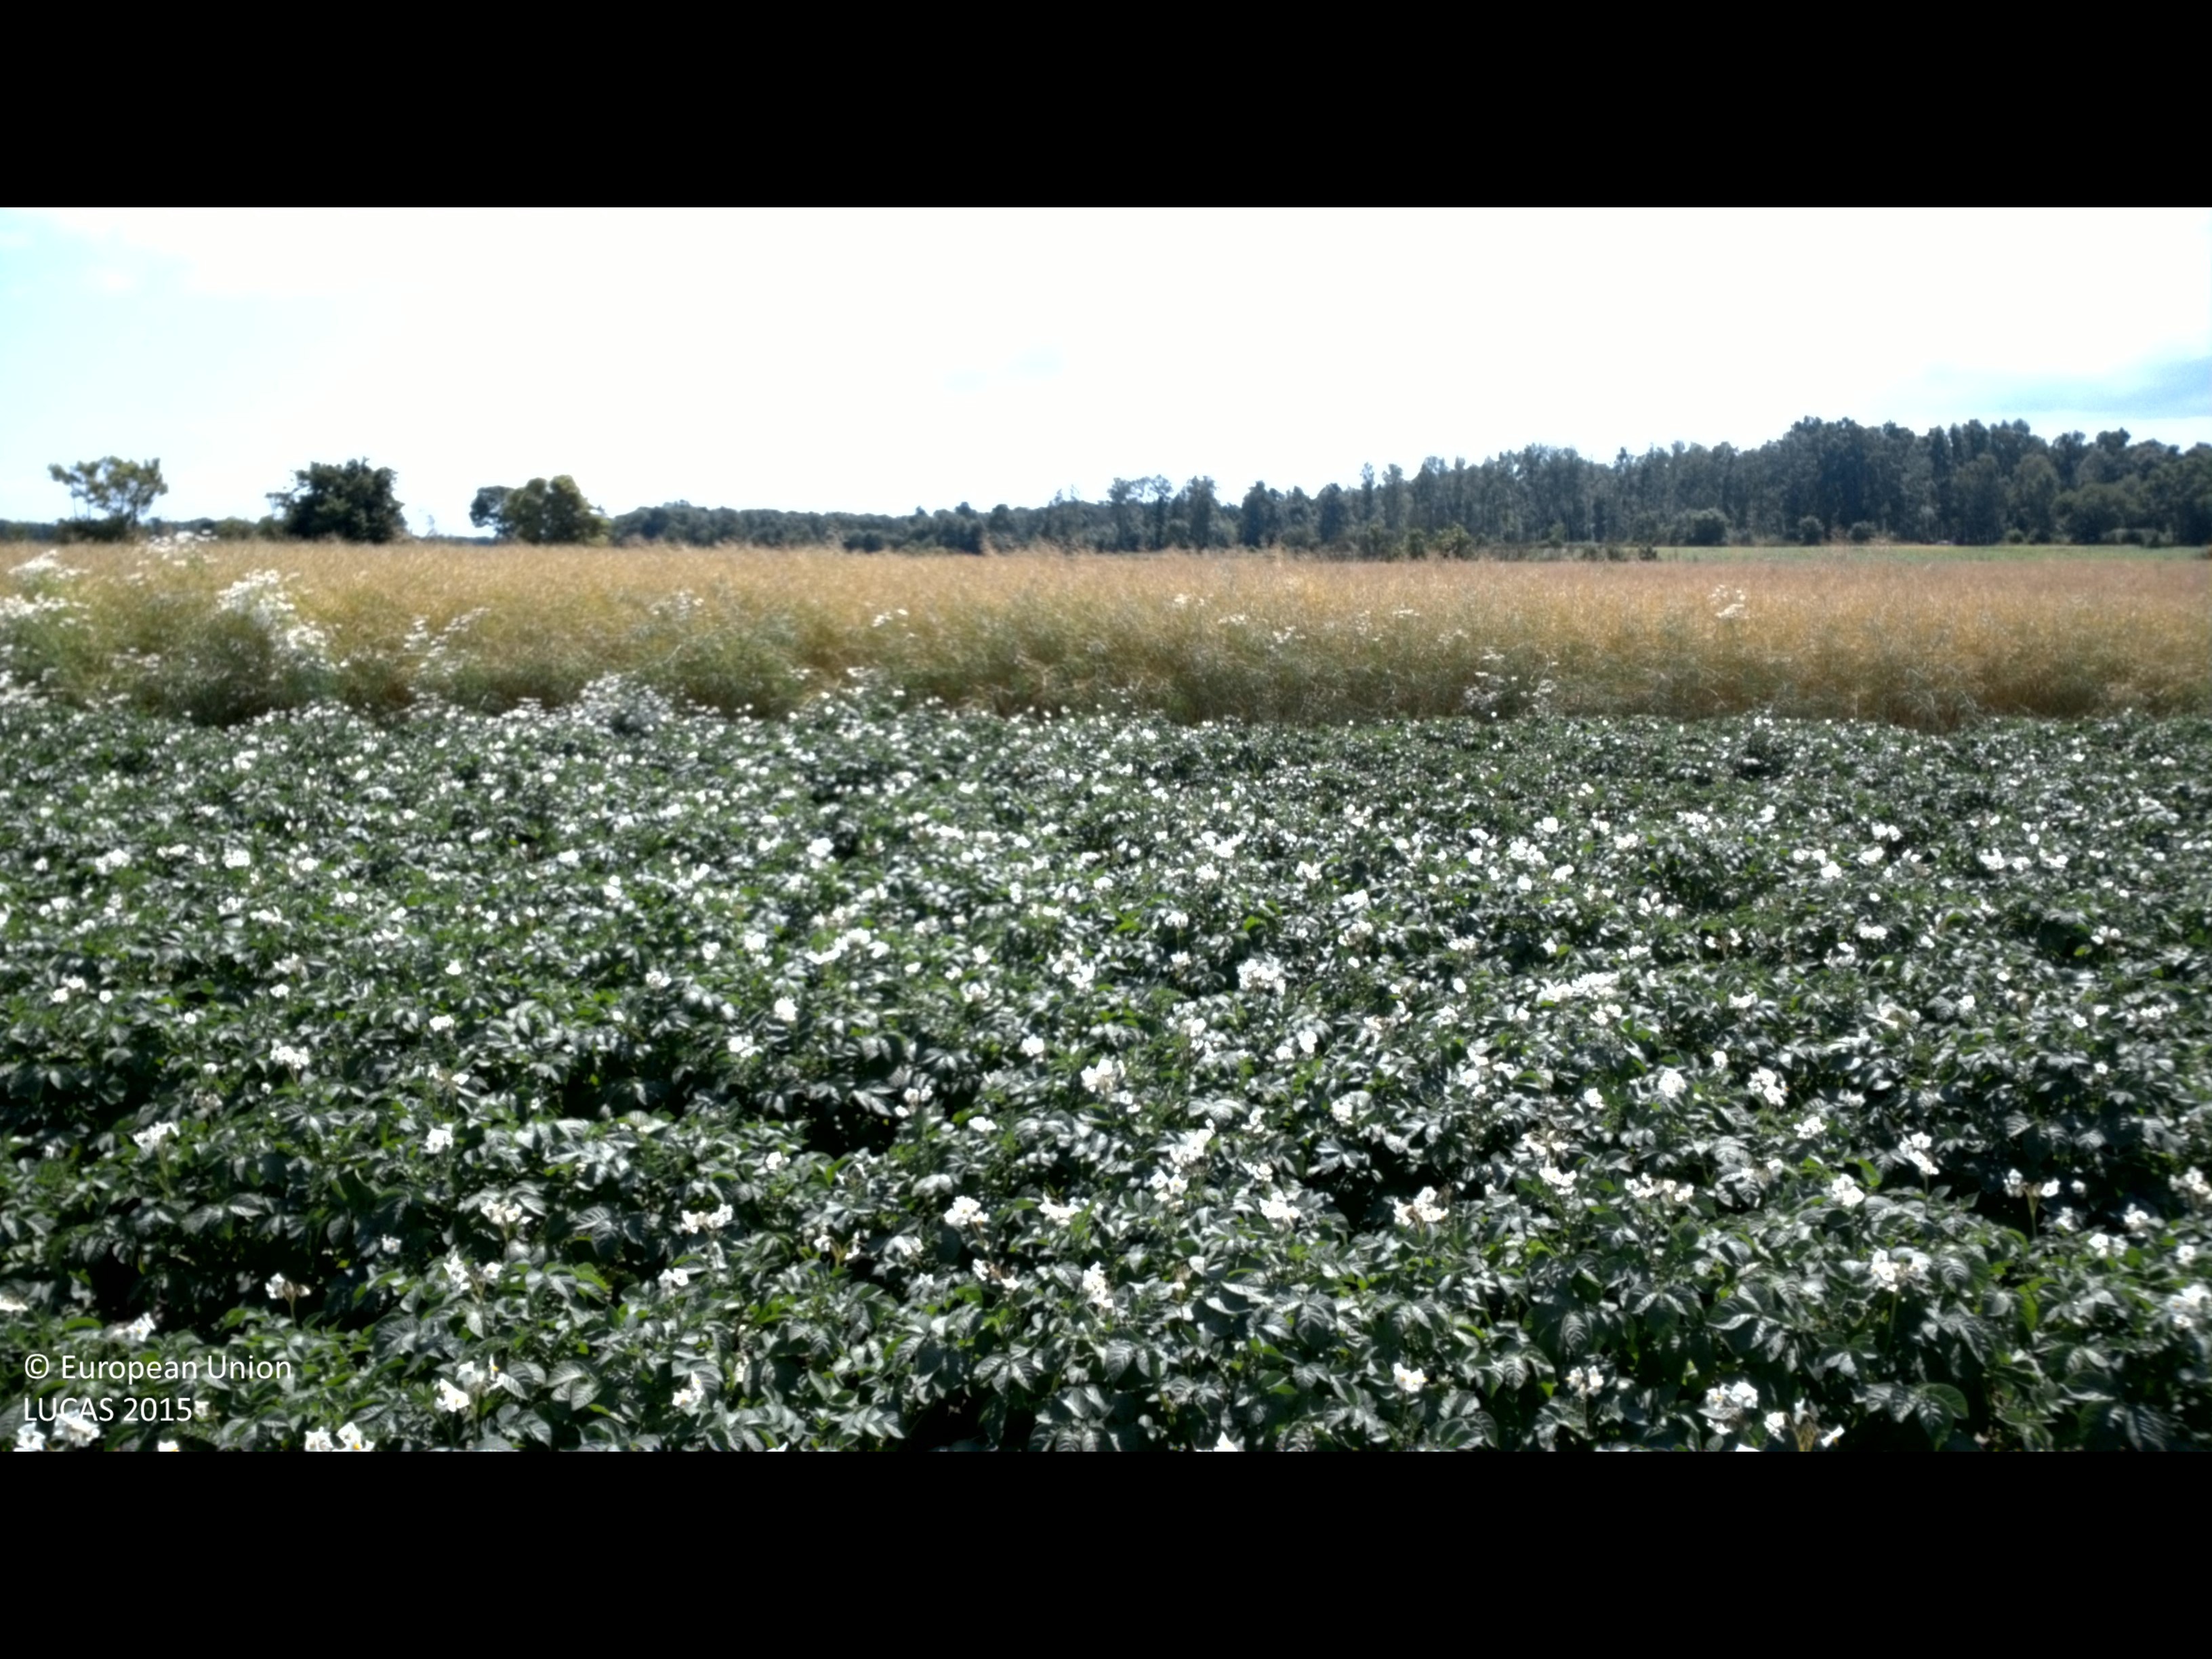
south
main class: Cropland
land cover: Potatoes
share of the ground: > 75 %
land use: Agriculture (excluding fallow land and kitchen gardens)
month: July
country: SE
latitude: 56.4426
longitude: 16.4088
